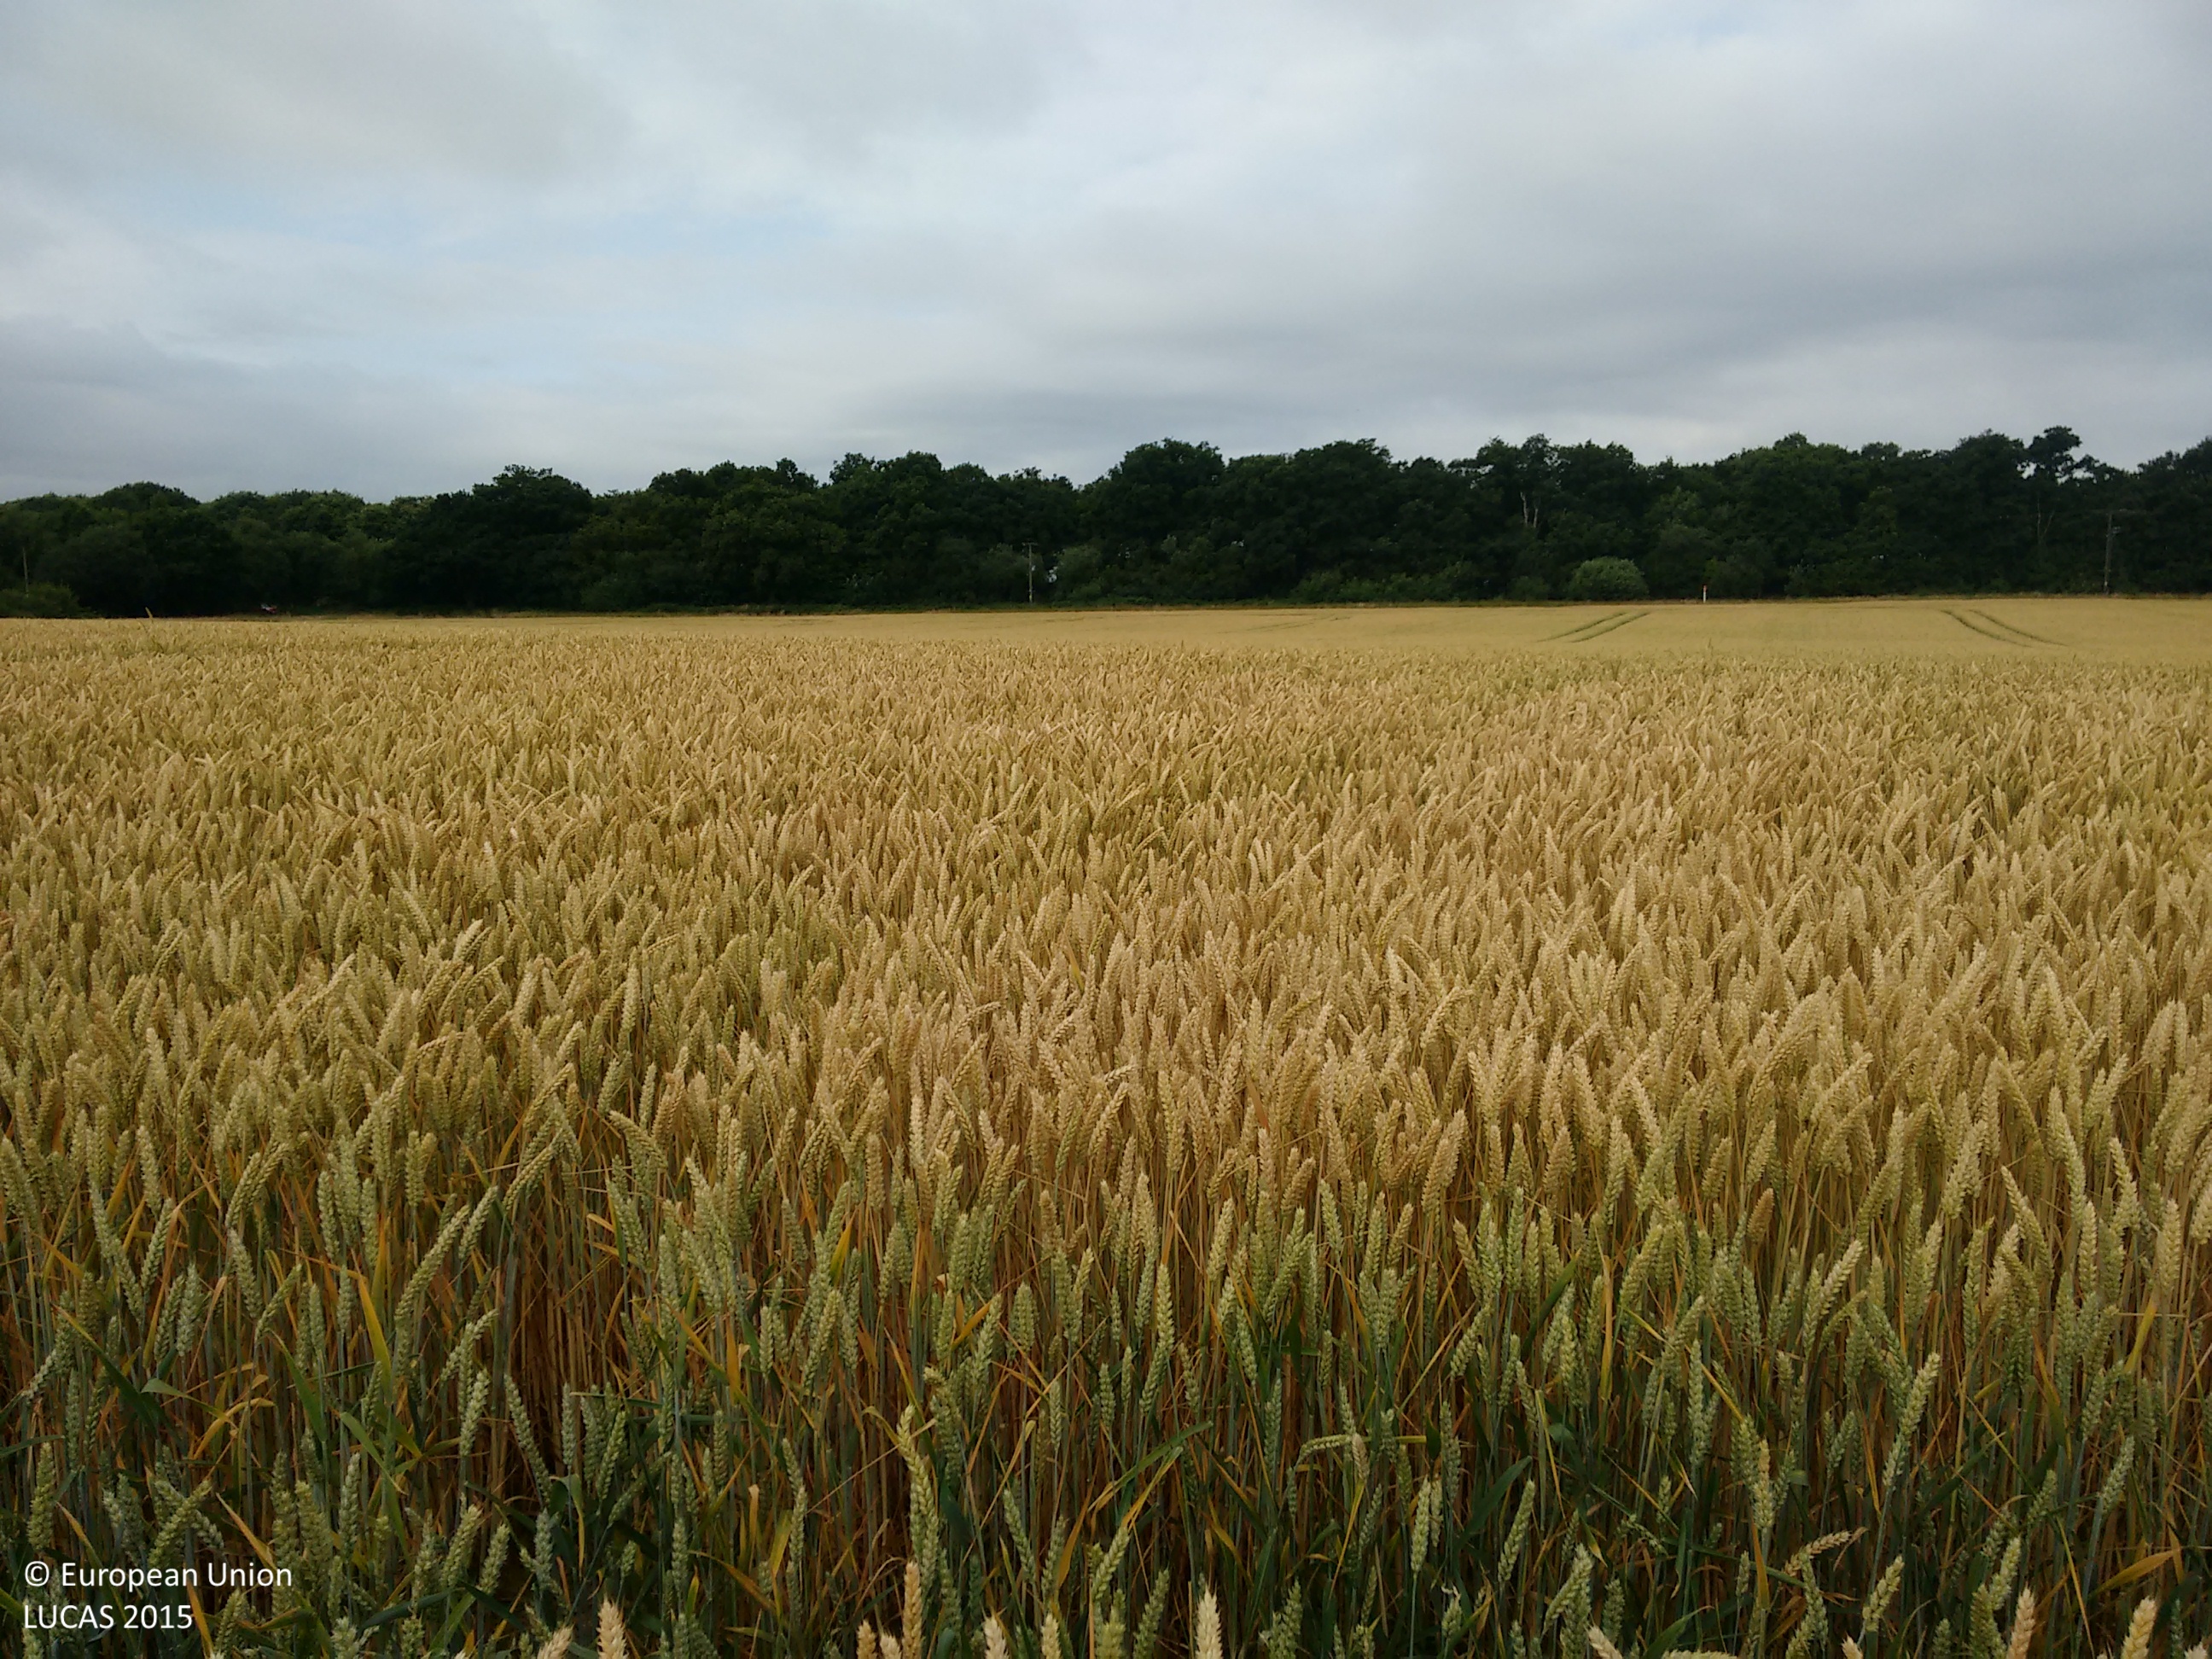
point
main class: Cropland
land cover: Common wheat
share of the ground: > 75 %
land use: Agriculture (excluding fallow land and kitchen gardens)
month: July
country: GB
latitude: 51.6854
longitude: 0.4687
